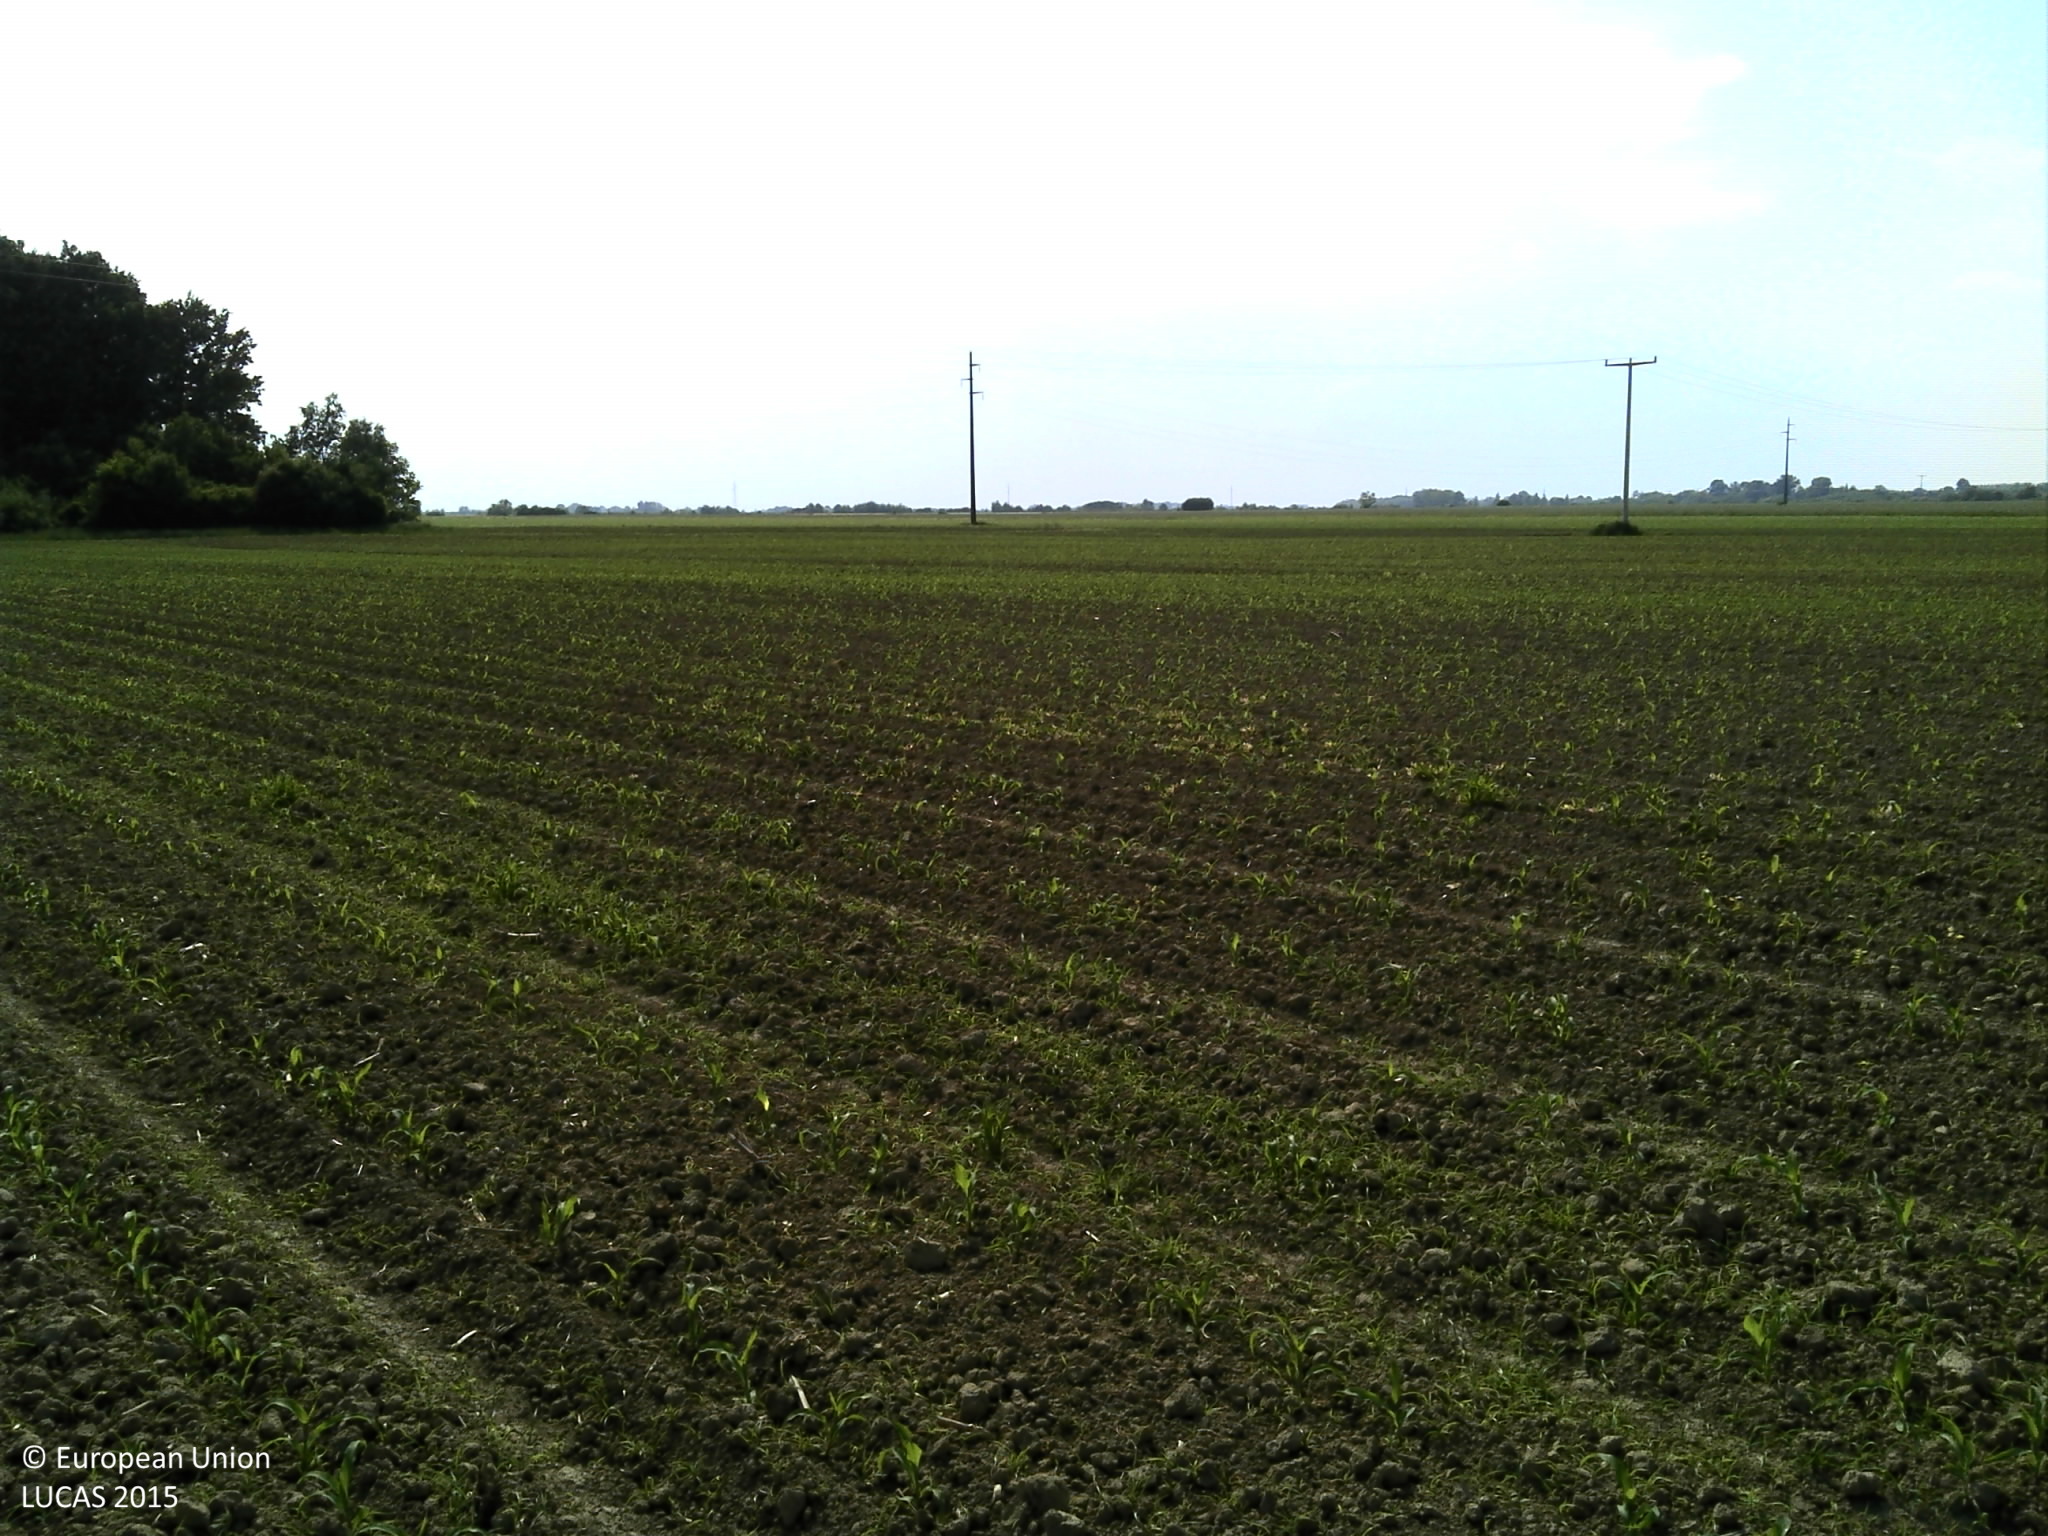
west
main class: Cropland
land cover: Maize
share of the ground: < 10 %
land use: Agriculture (excluding fallow land and kitchen gardens)
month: May
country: HR
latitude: 45.7031
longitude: 18.2904
